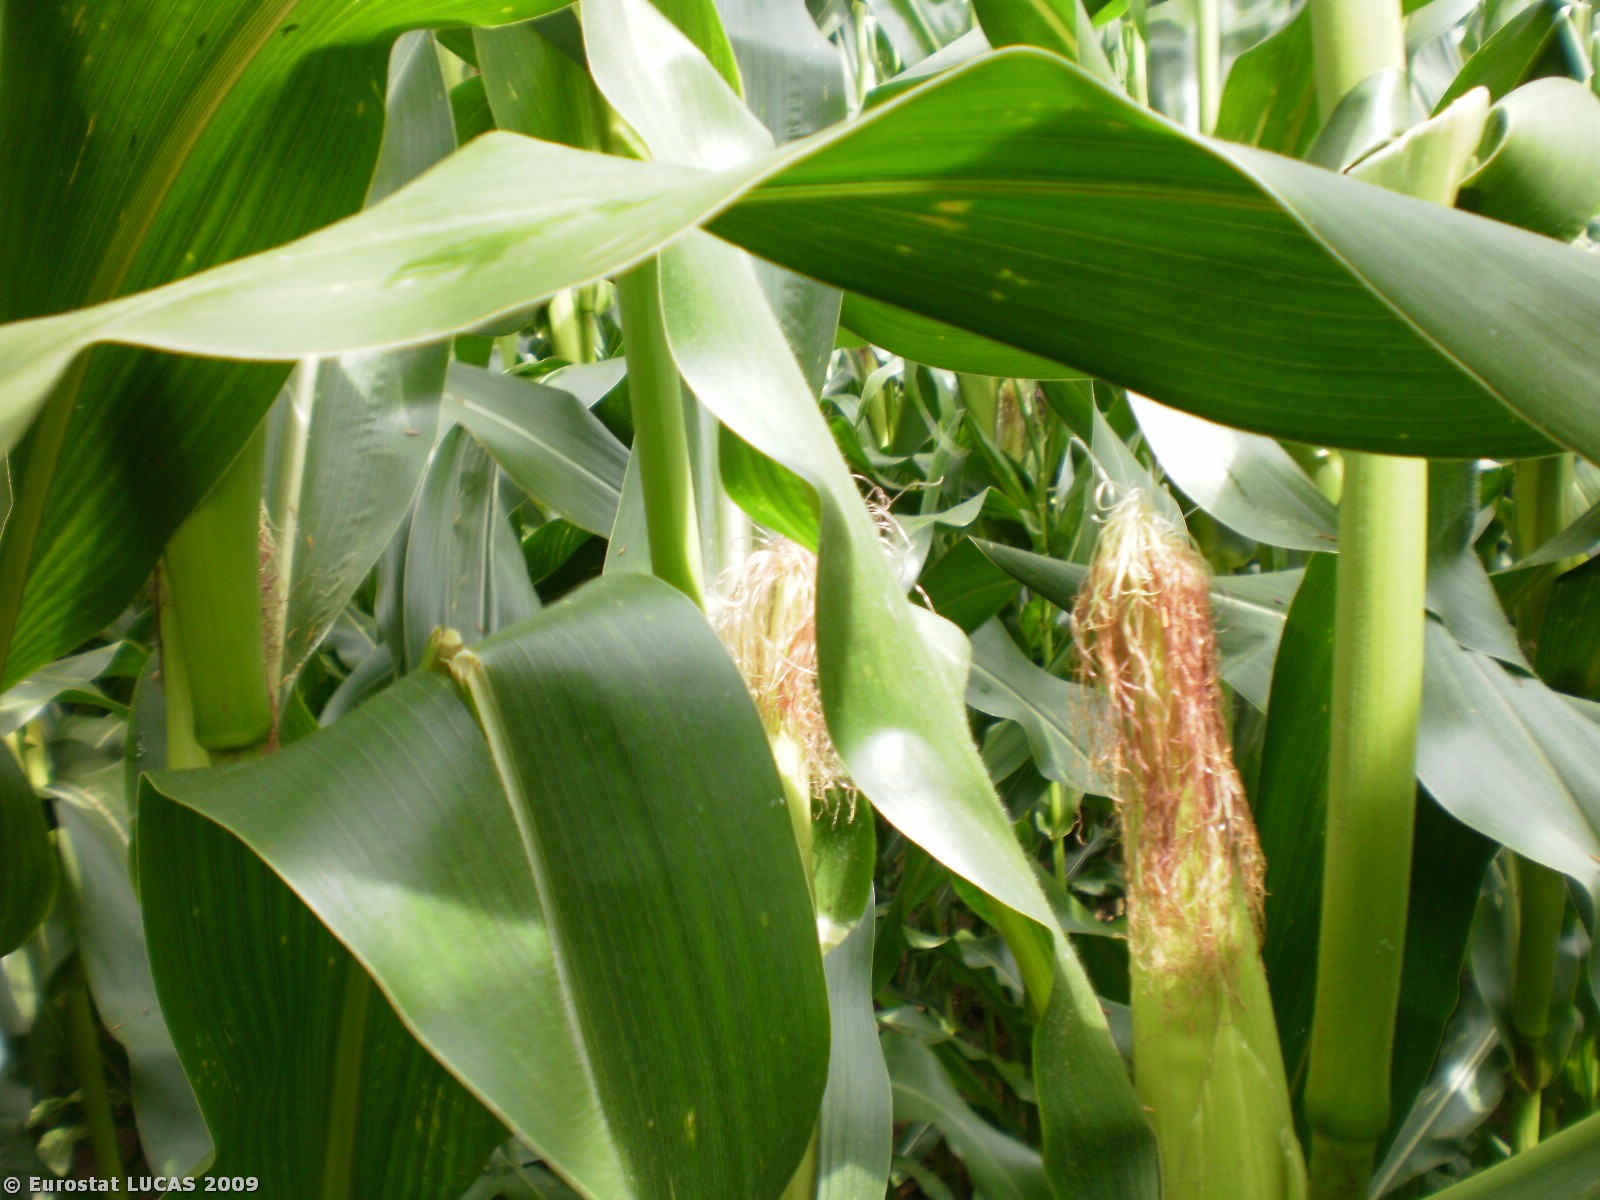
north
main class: Cropland
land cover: Maize
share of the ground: > 75 %
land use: Agriculture (excluding fallow land and kitchen gardens)
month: July
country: BE
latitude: 50.7885
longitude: 2.8255
